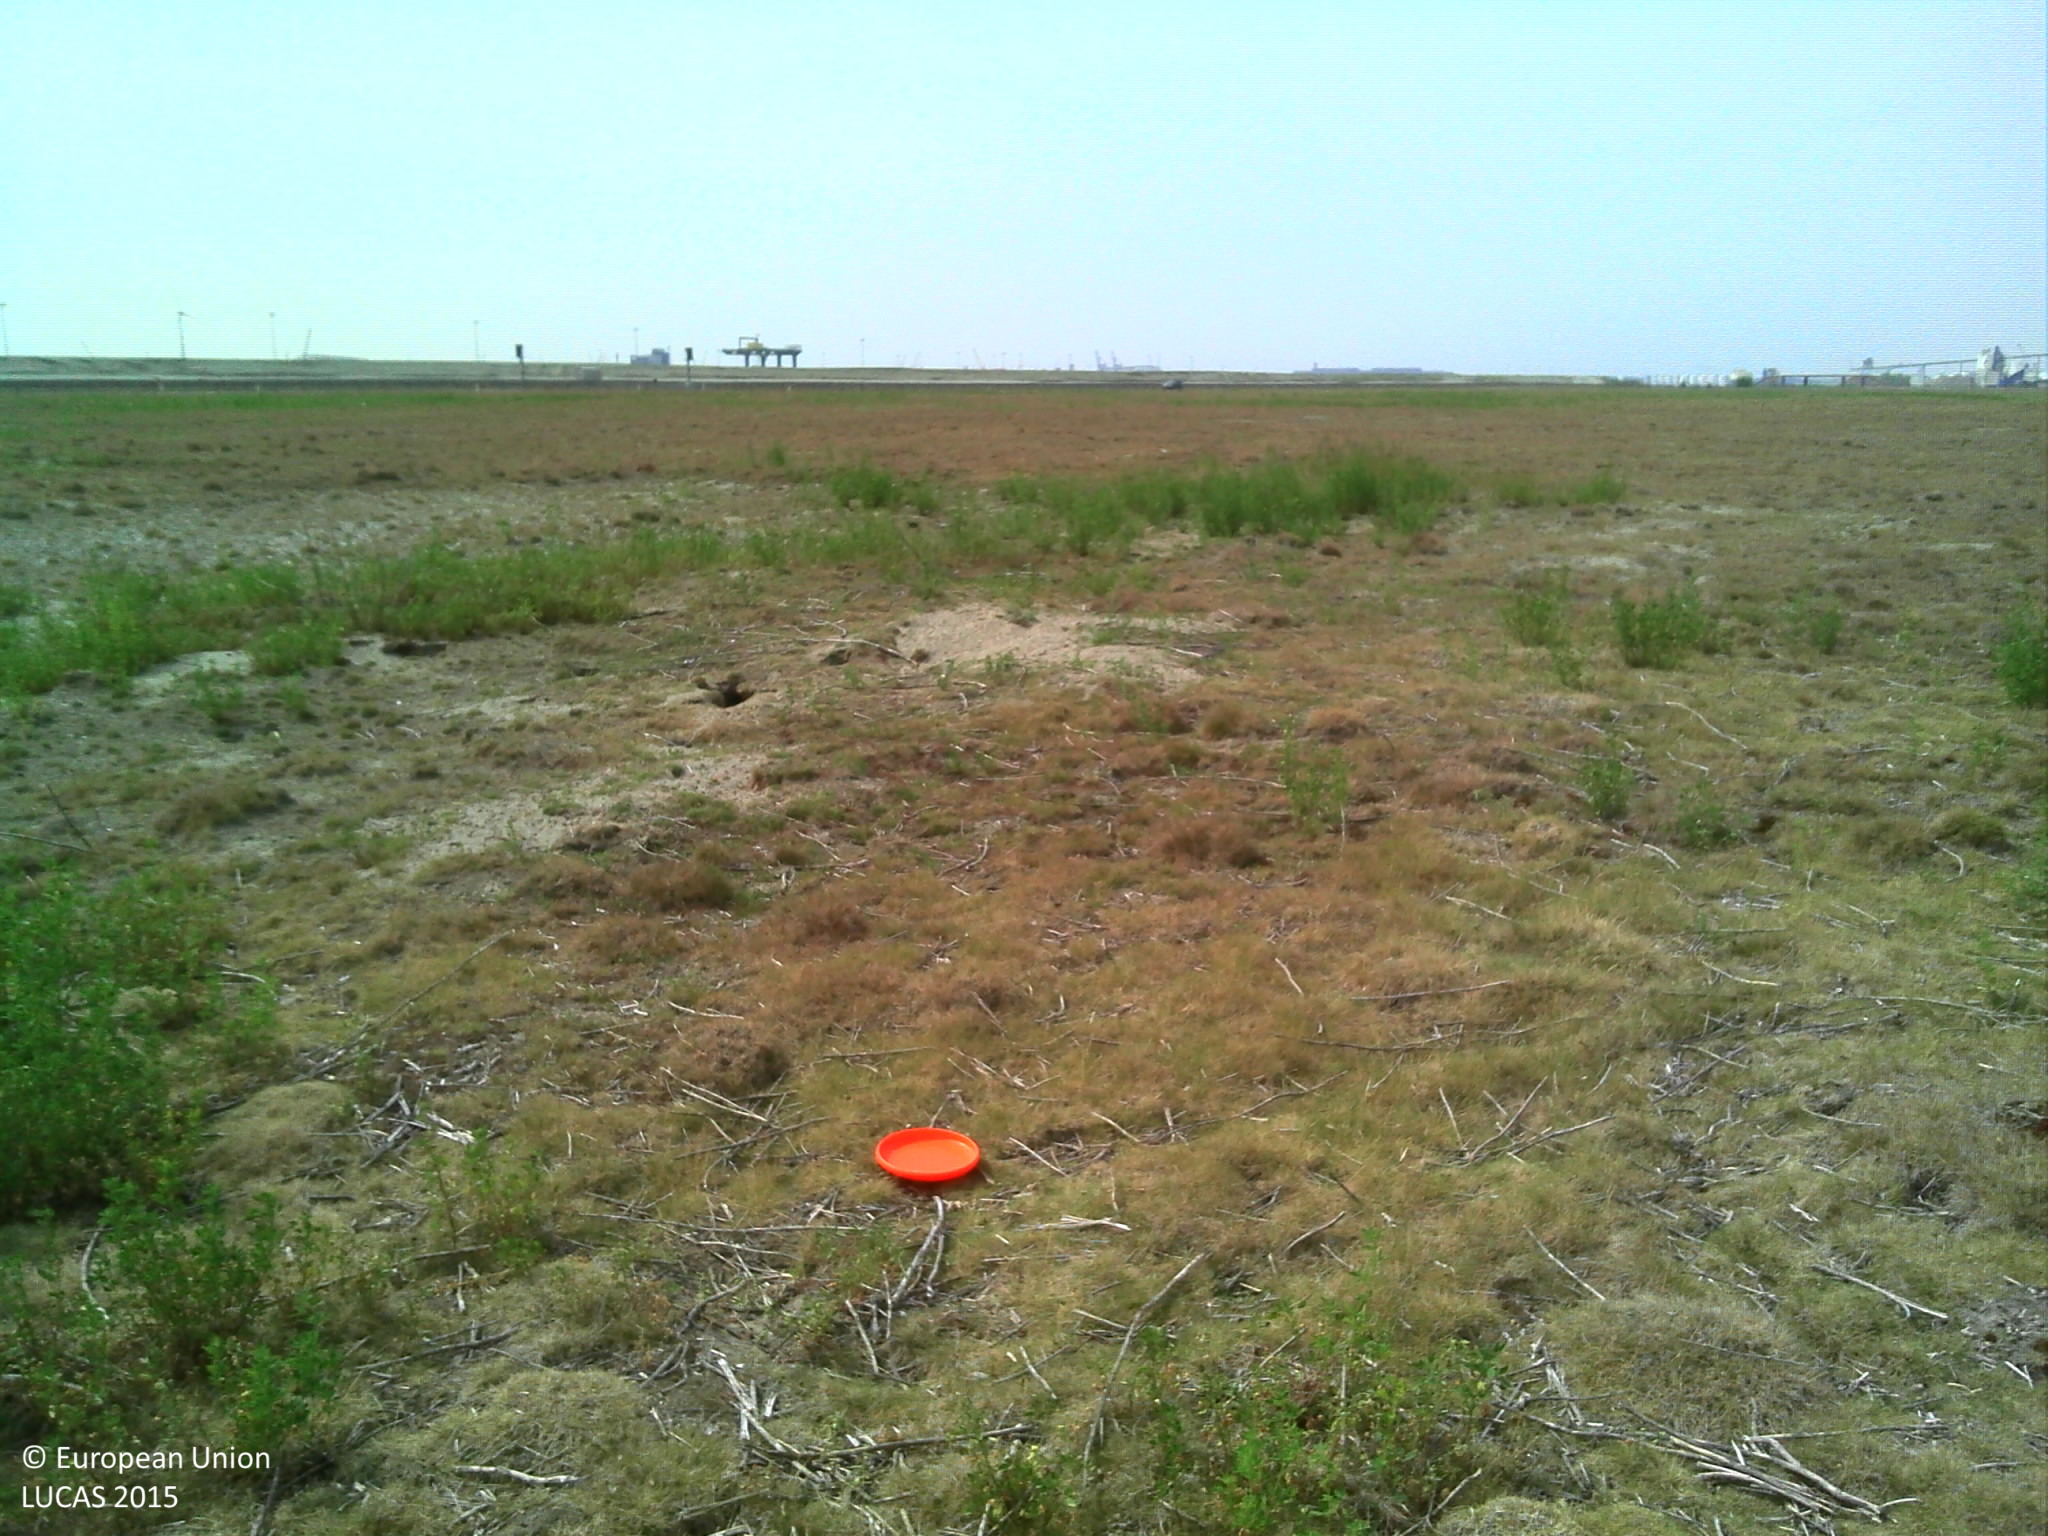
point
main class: Grassland
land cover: Spontaneously vegetated surfaces
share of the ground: > 75 %
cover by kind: herbaceous plants 100 %
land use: Semi-natural and natural areas not in use
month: June
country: BE
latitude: 51.3007
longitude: 4.2435
